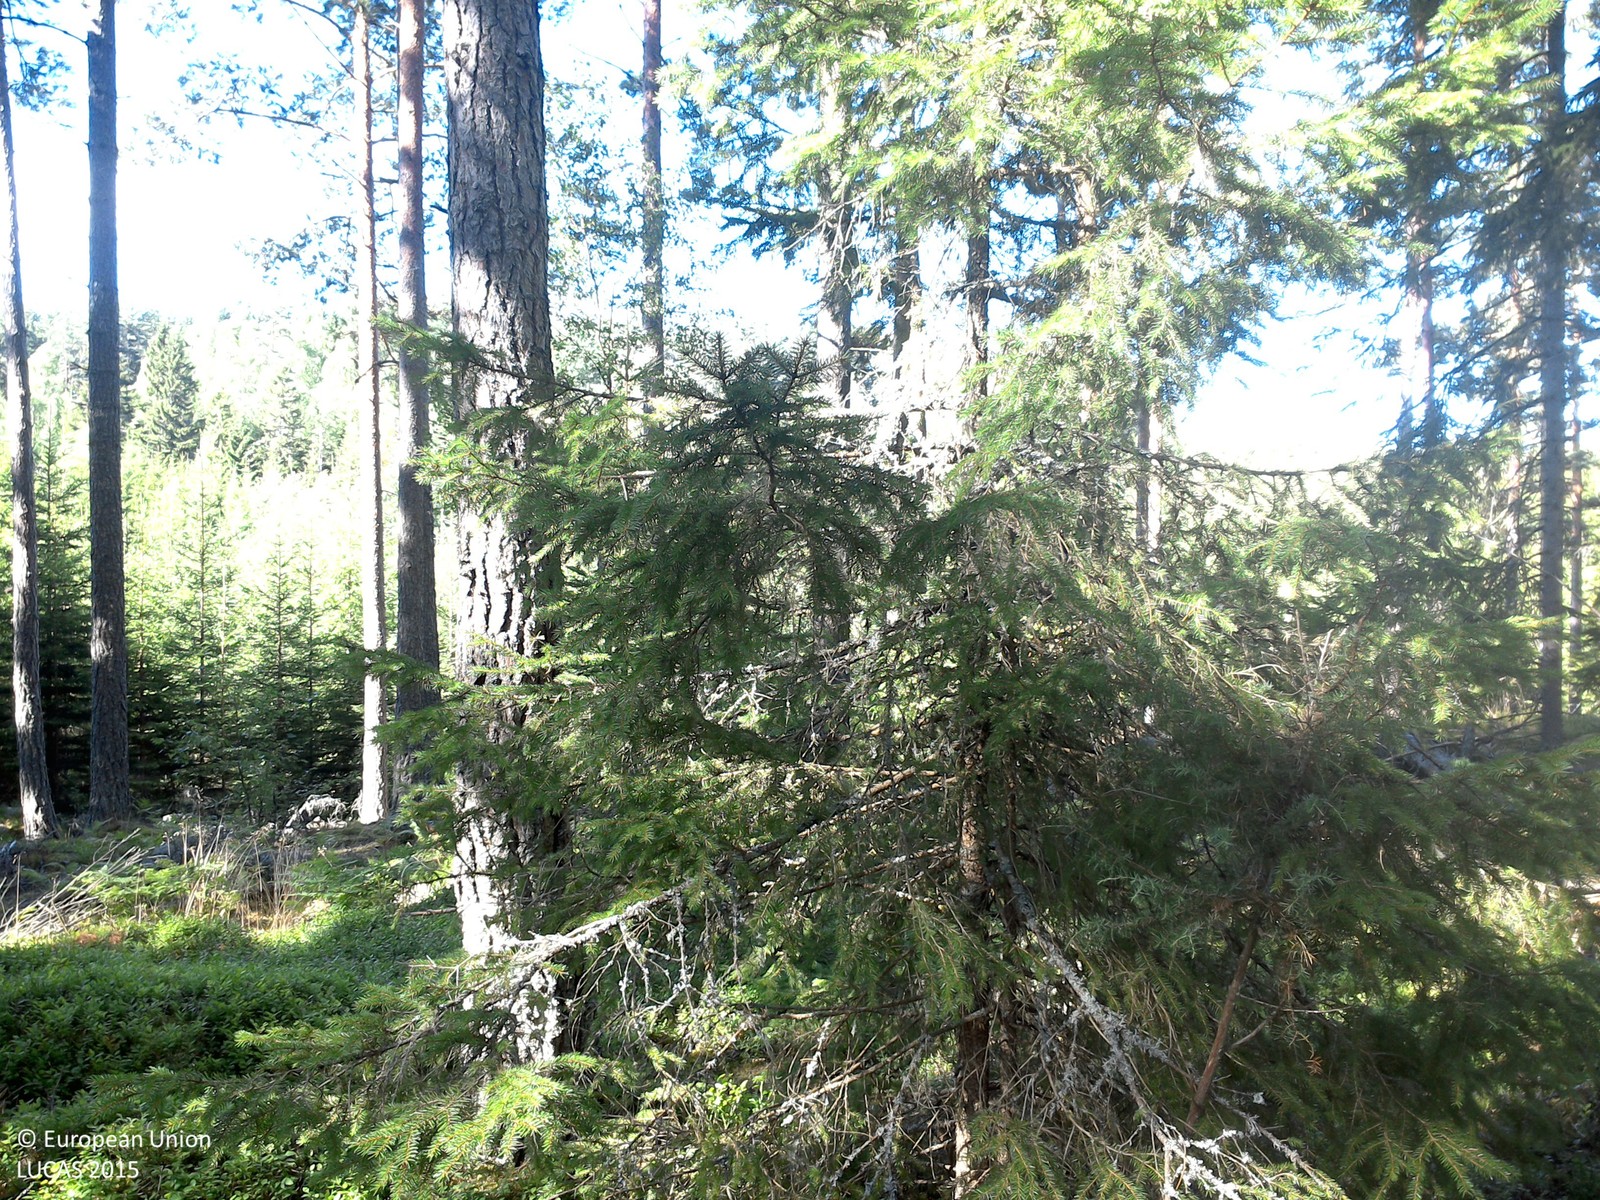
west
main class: Woodland
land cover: Pine dominated coniferous woodland
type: boreal forest
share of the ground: 25 - 50 %
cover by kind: coniferous forest trees 40 %, lichens and mosses 40 %, herbaceous plants 20 %
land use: Forestry
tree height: > 5 m
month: August
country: SE
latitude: 57.8804
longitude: 15.3074
